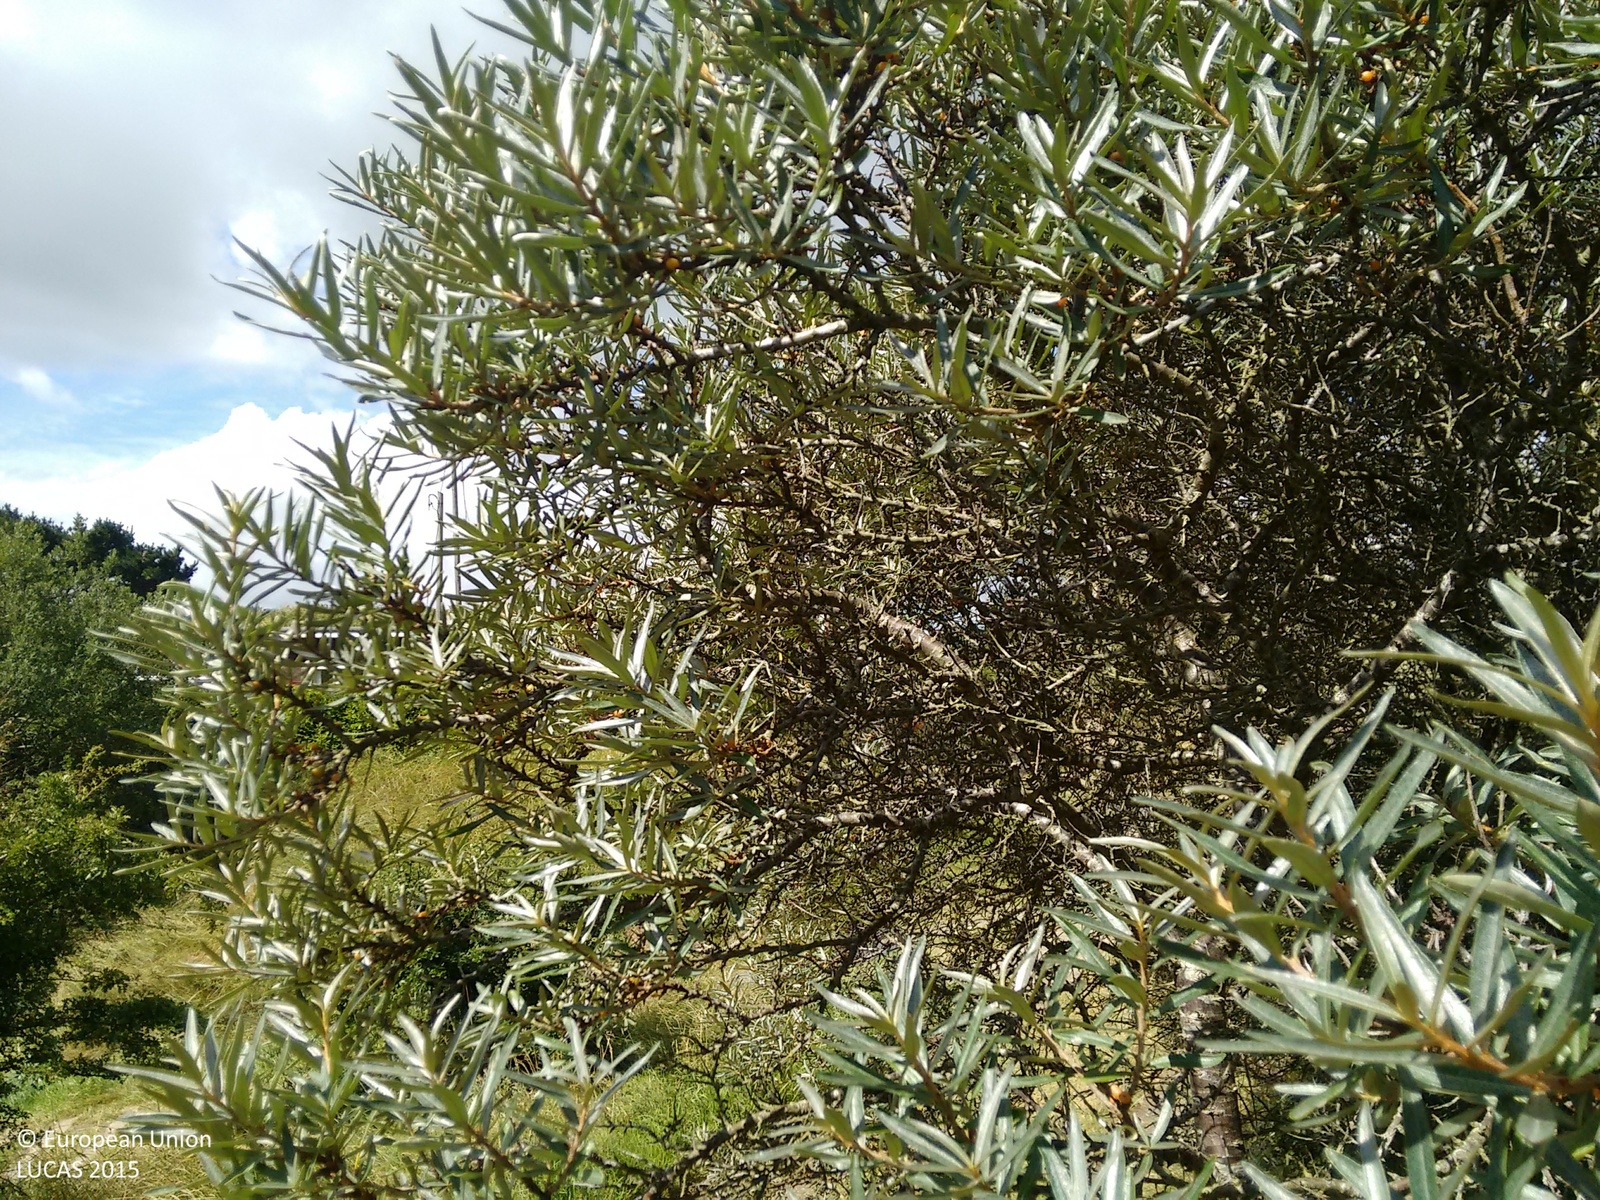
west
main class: Shrubland
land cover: Shrubland without tree cover
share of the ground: > 75 %
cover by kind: shrubs 95 %, herbaceous plants 5 %
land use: Semi-natural and natural areas not in use
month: August
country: IE
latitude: 52.7075
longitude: -6.1770
